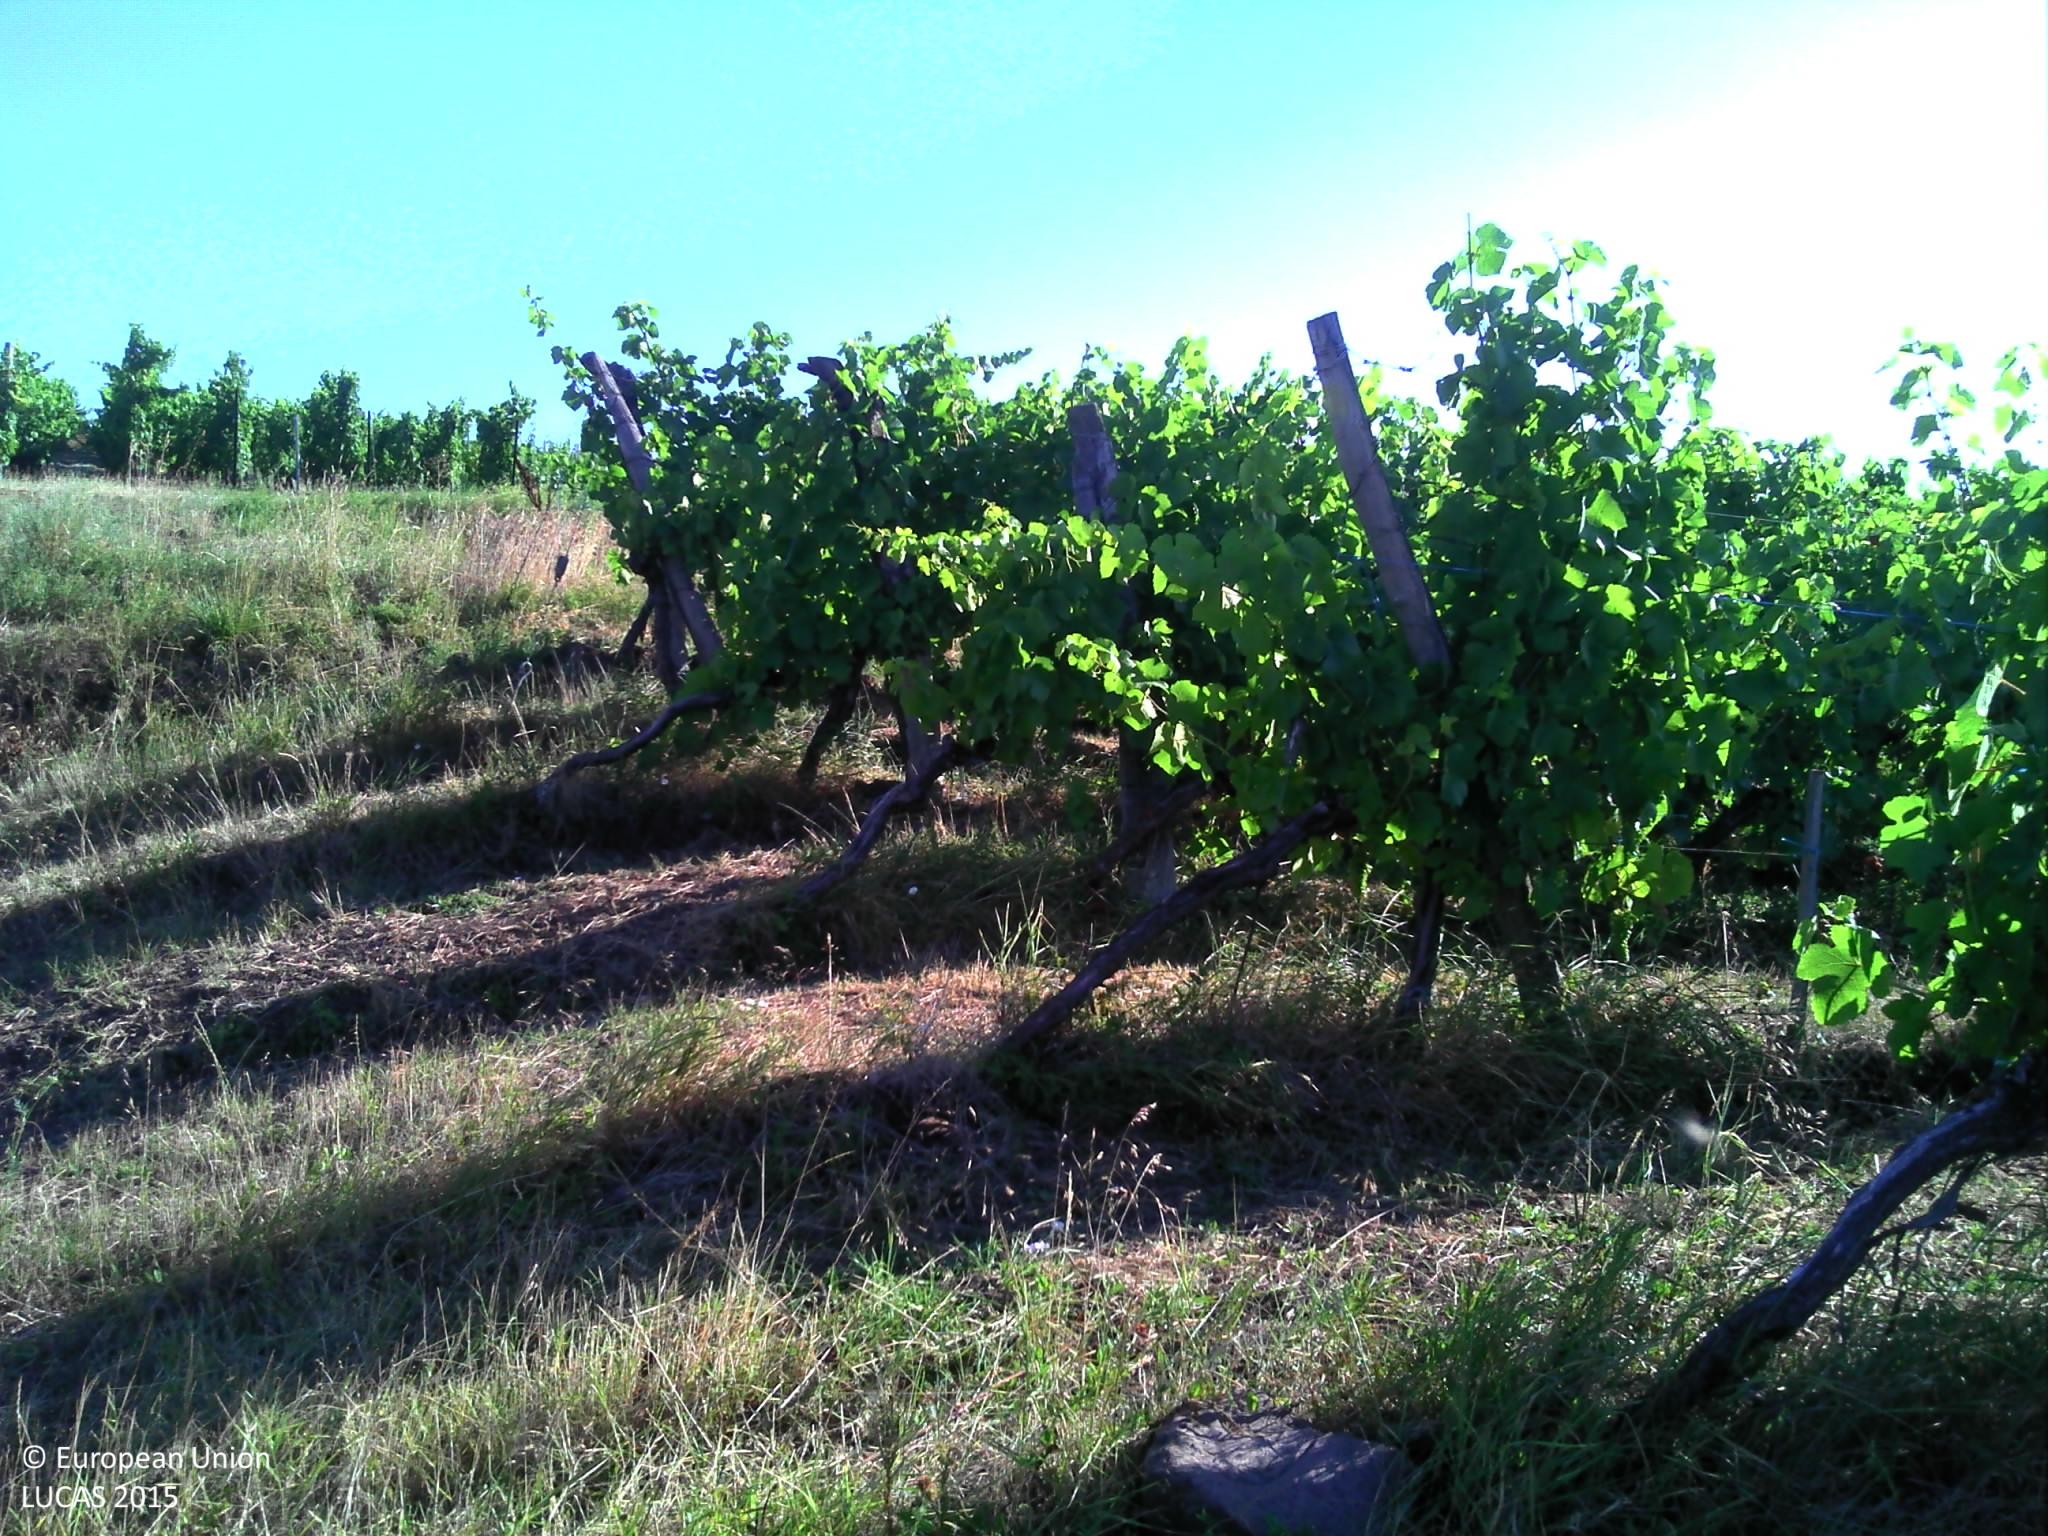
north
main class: Grassland
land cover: Grassland without tree/shrub cover
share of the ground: > 75 %
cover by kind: herbaceous plants 100 %
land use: Agriculture (excluding fallow land and kitchen gardens)
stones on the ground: < 10 %
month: July
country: FR
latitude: 48.6085
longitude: 7.4646
